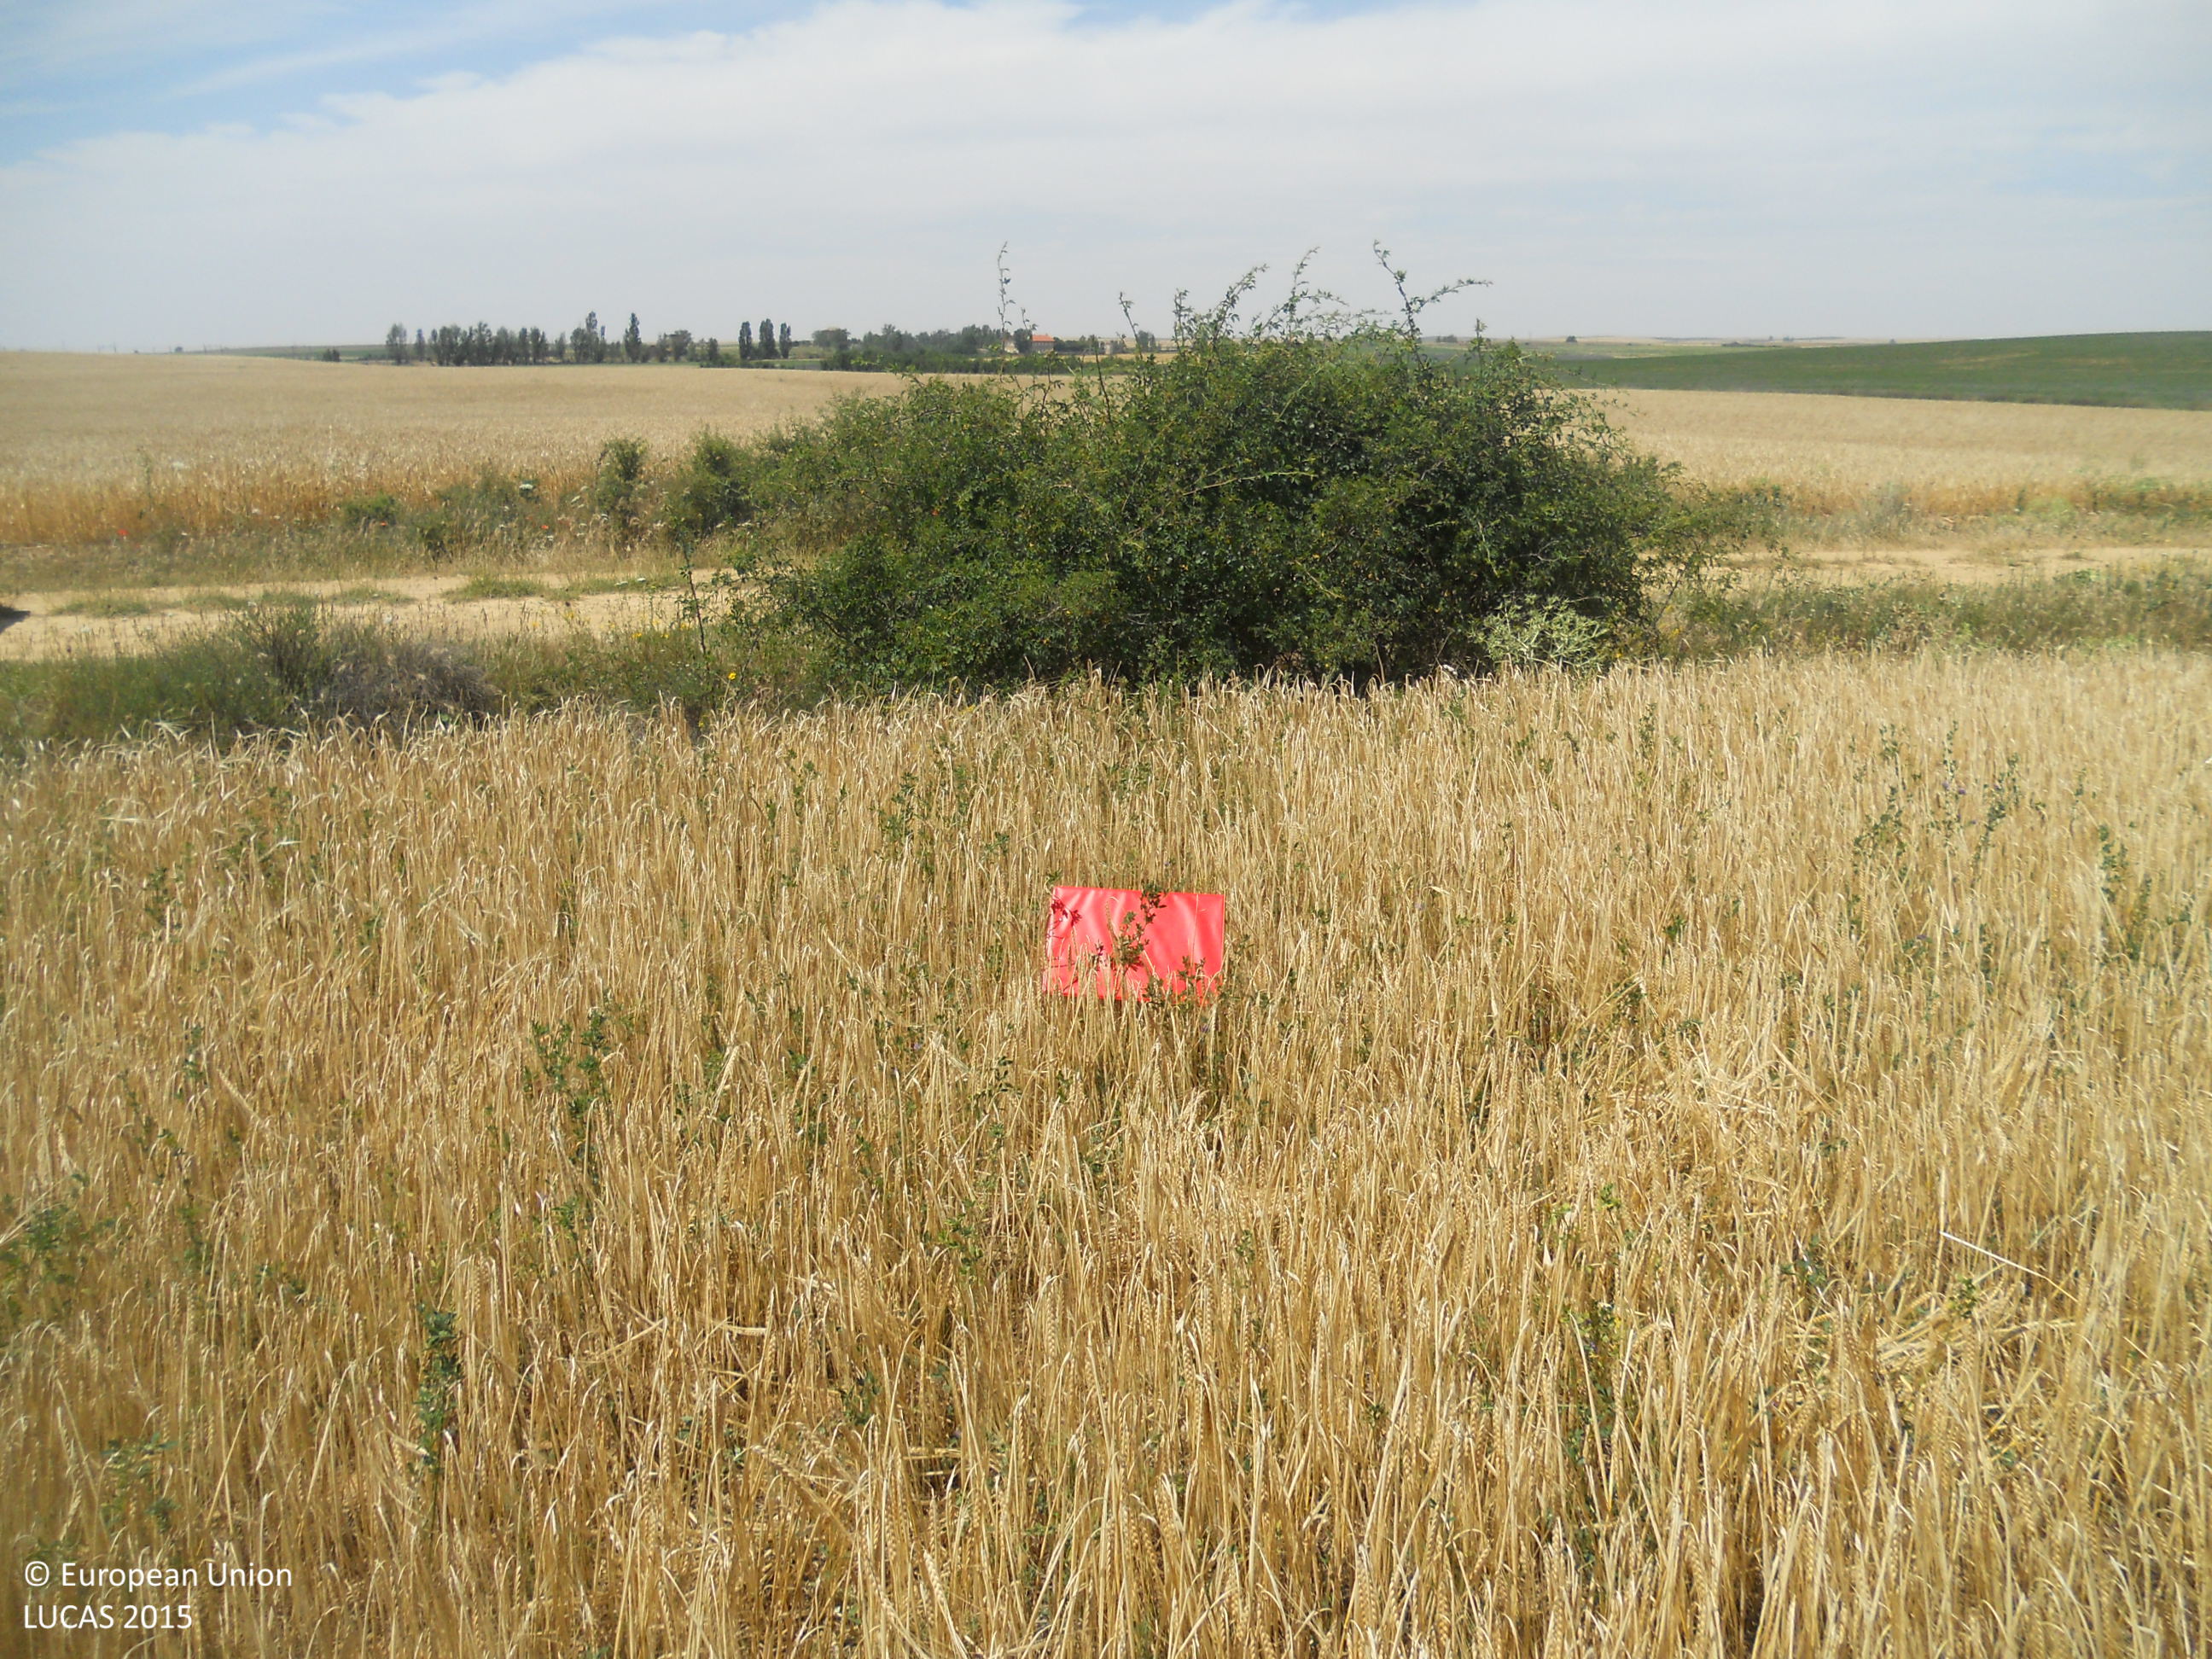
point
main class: Cropland
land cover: Barley
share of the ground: > 75 %
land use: Agriculture (excluding fallow land and kitchen gardens)
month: July
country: ES
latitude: 42.1955
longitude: -4.8399
